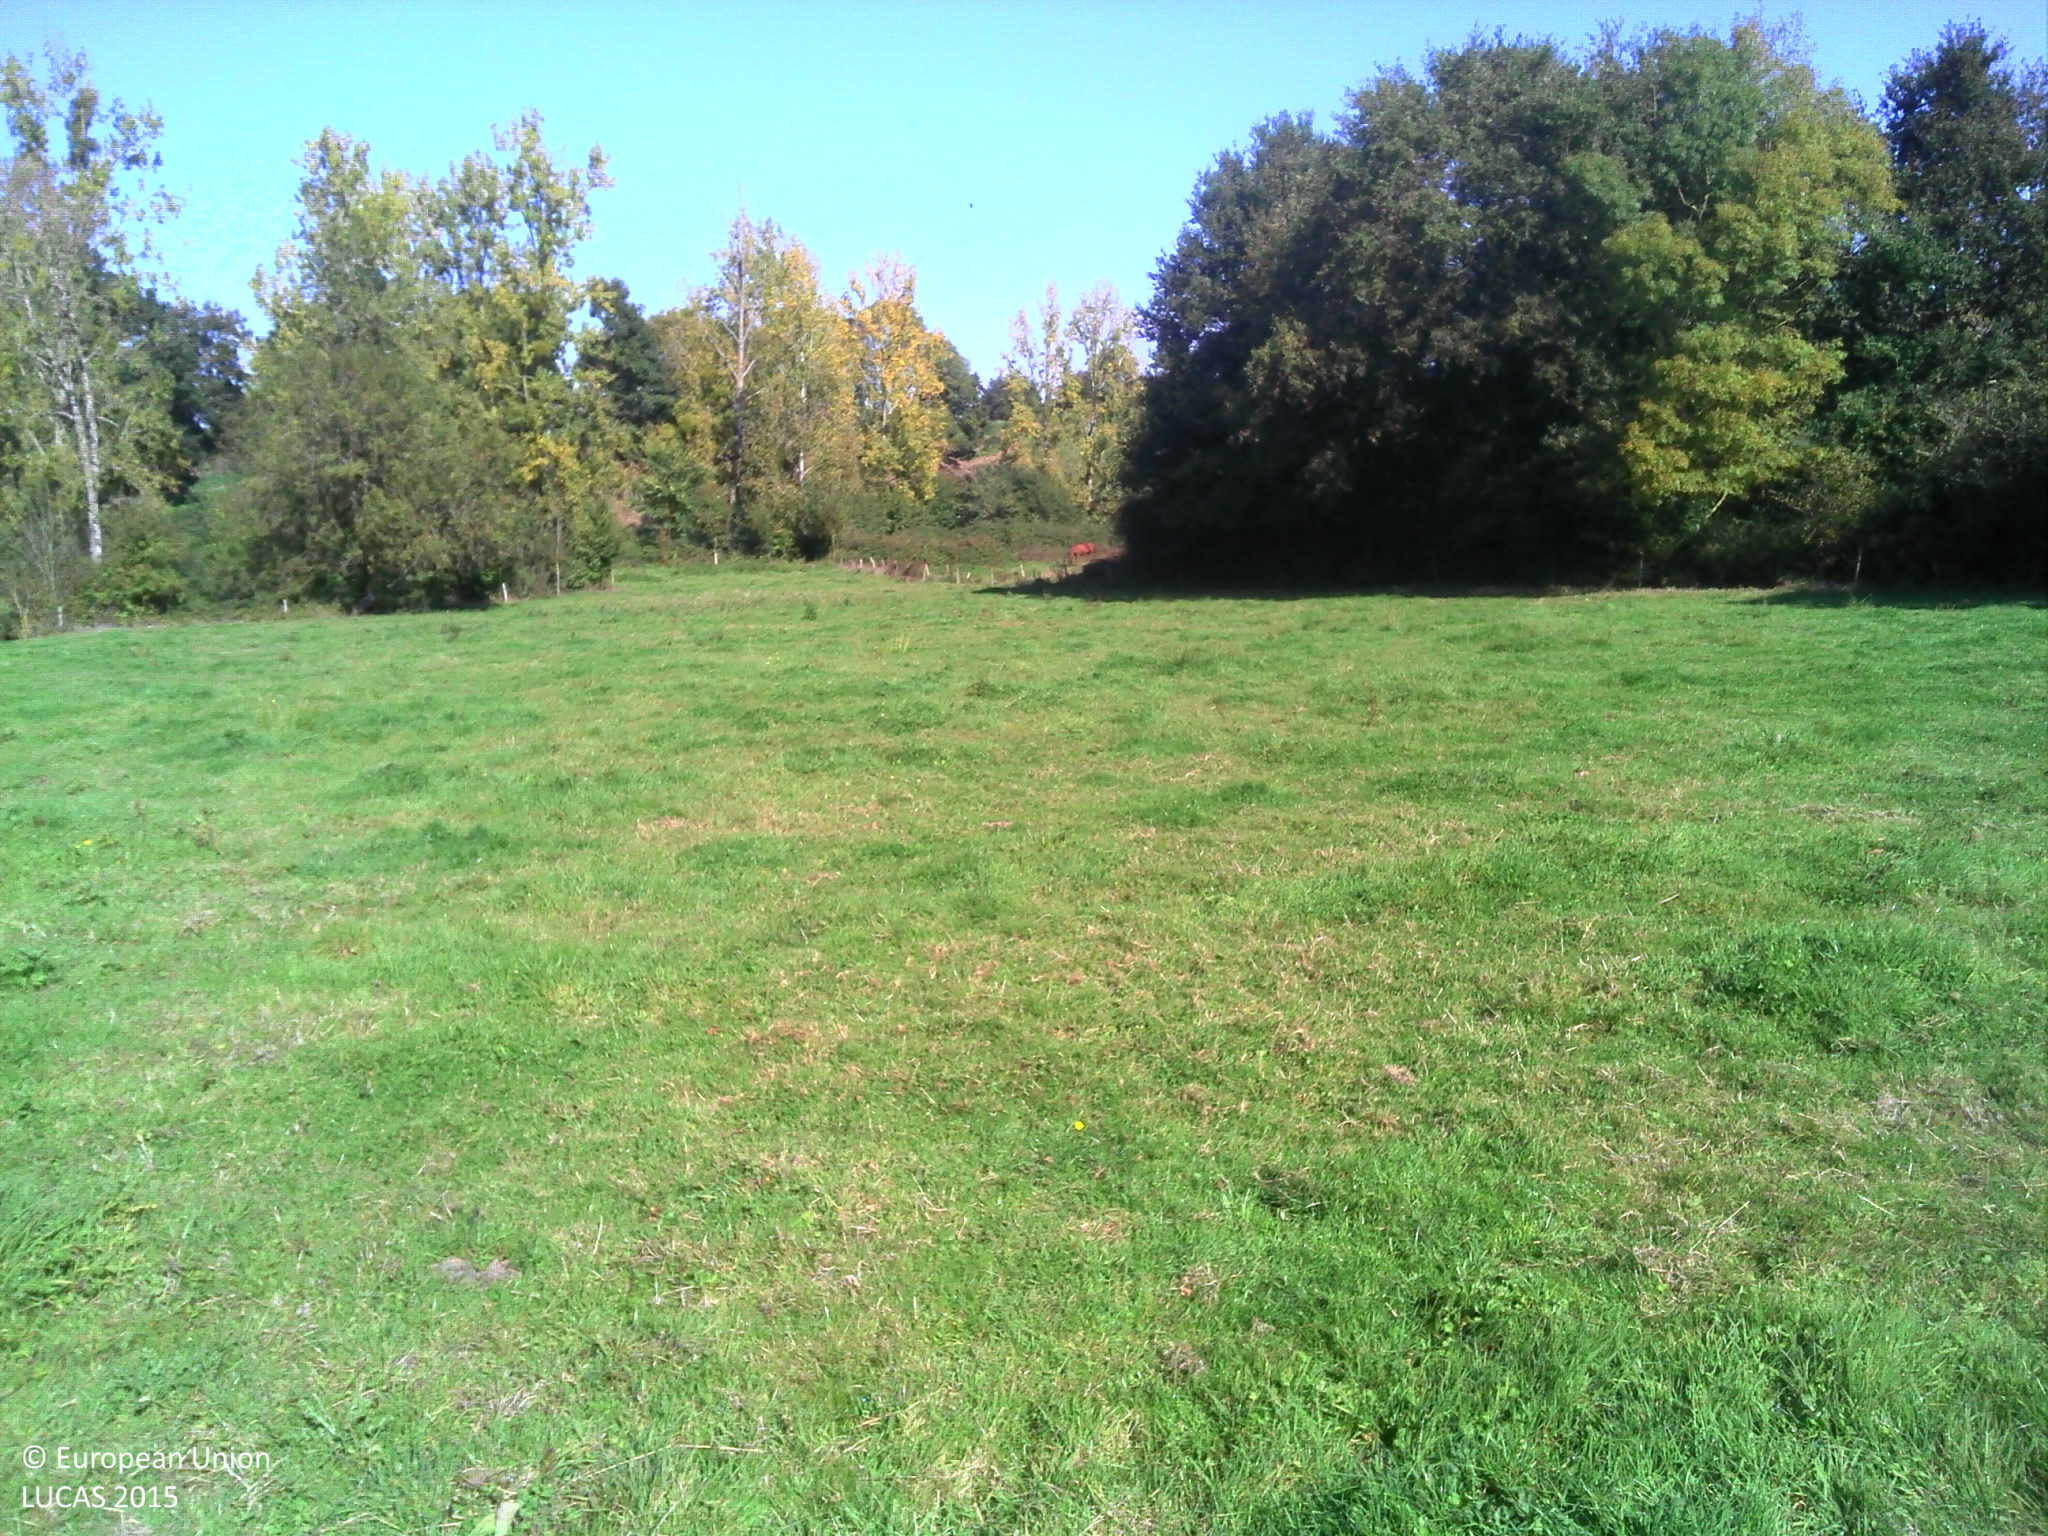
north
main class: Grassland
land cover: Grassland without tree/shrub cover
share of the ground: > 75 %
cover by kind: herbaceous plants 100 %
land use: Agriculture (excluding fallow land and kitchen gardens)
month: October
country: FR
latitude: 46.8421
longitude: -1.4602
